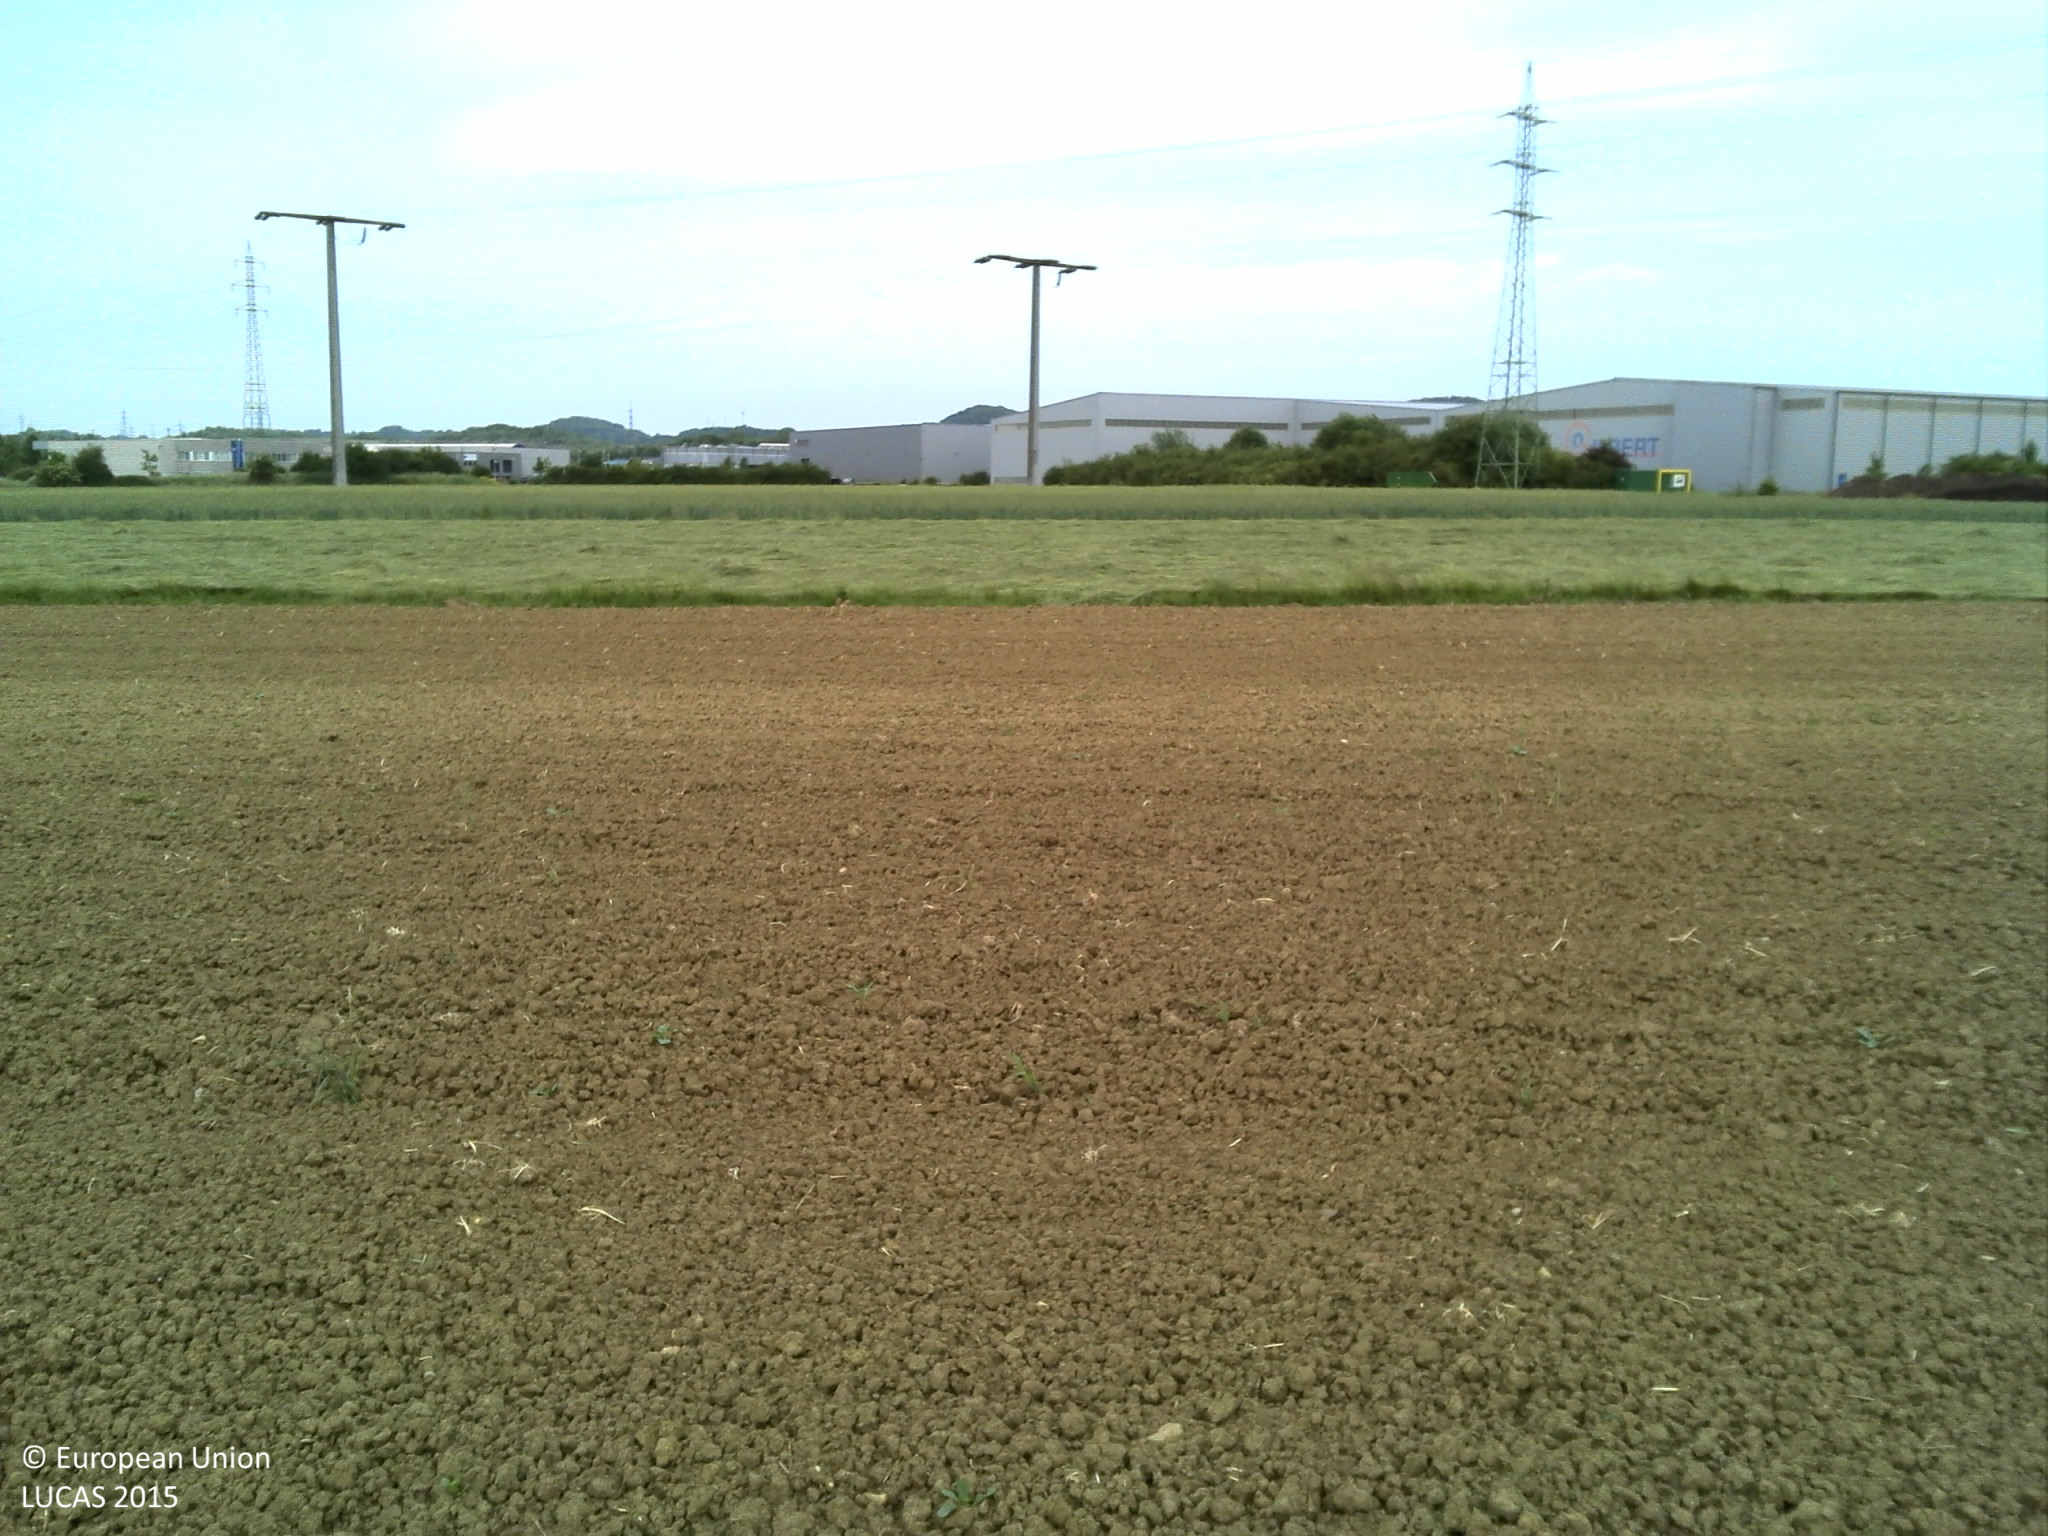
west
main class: Cropland
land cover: Maize
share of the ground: < 10 %
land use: Agriculture (excluding fallow land and kitchen gardens)
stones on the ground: < 10 %
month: June
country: LU
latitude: 49.5192
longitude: 5.9796
